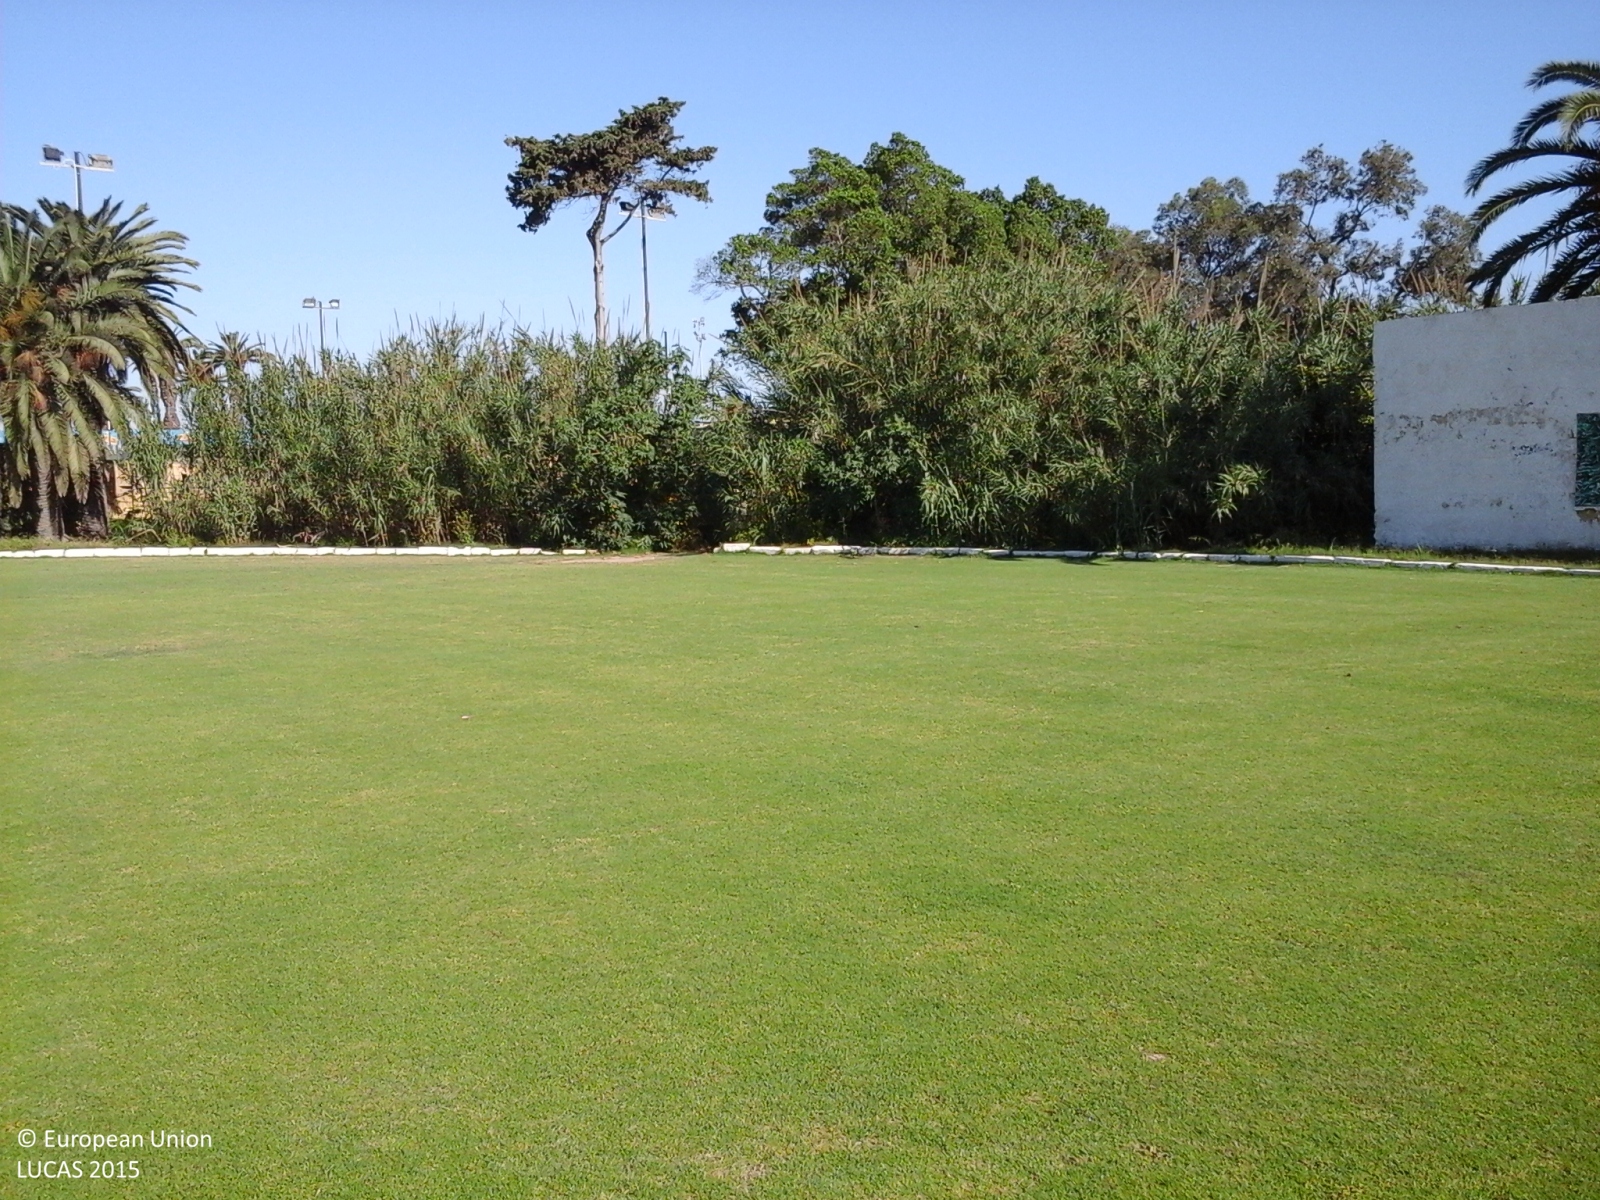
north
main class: Grassland
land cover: Grassland without tree/shrub cover
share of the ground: > 75 %
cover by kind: herbaceous plants 100 %
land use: Sport
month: May
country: MT
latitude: 35.8763
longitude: 14.4886
